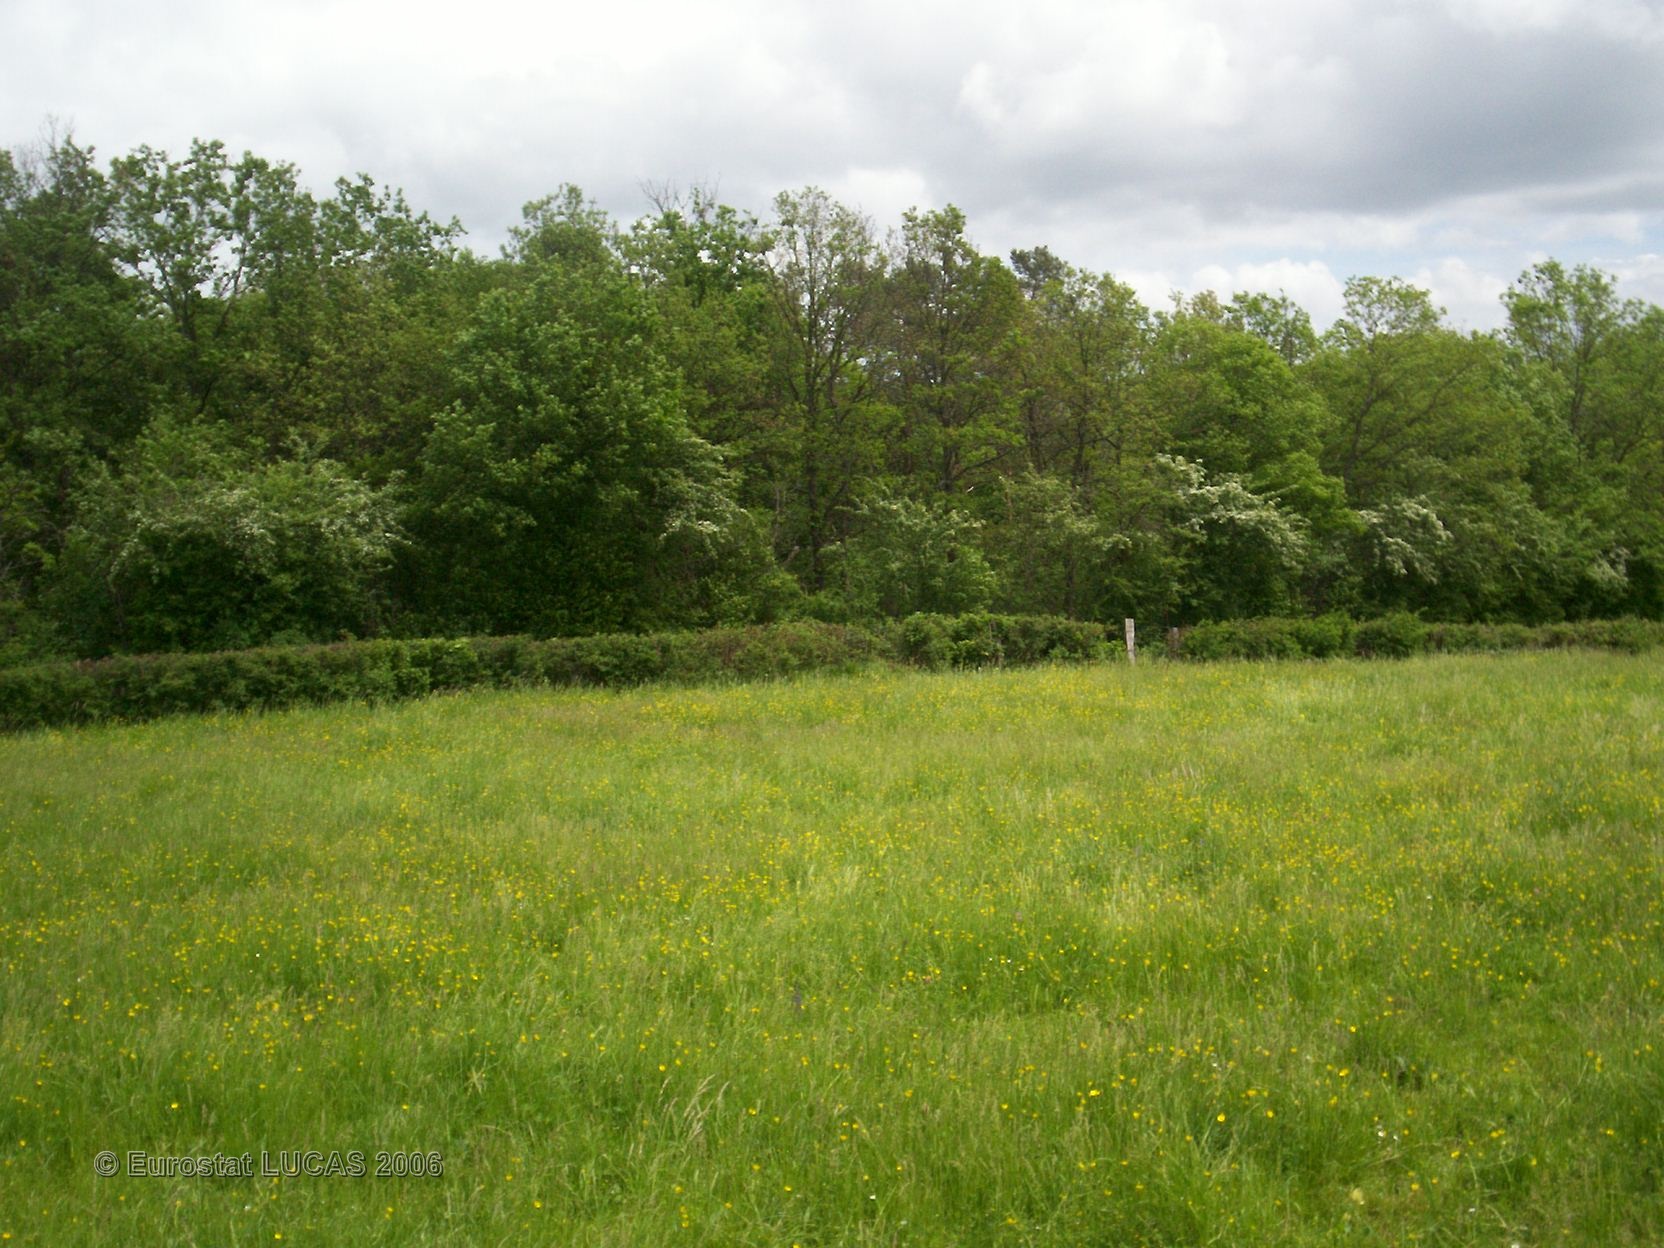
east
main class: Grassland
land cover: Grassland without tree/shrub cover
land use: Agriculture (excluding fallow land and kitchen gardens)
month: May
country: FR
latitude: 47.1574
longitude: 4.6847
